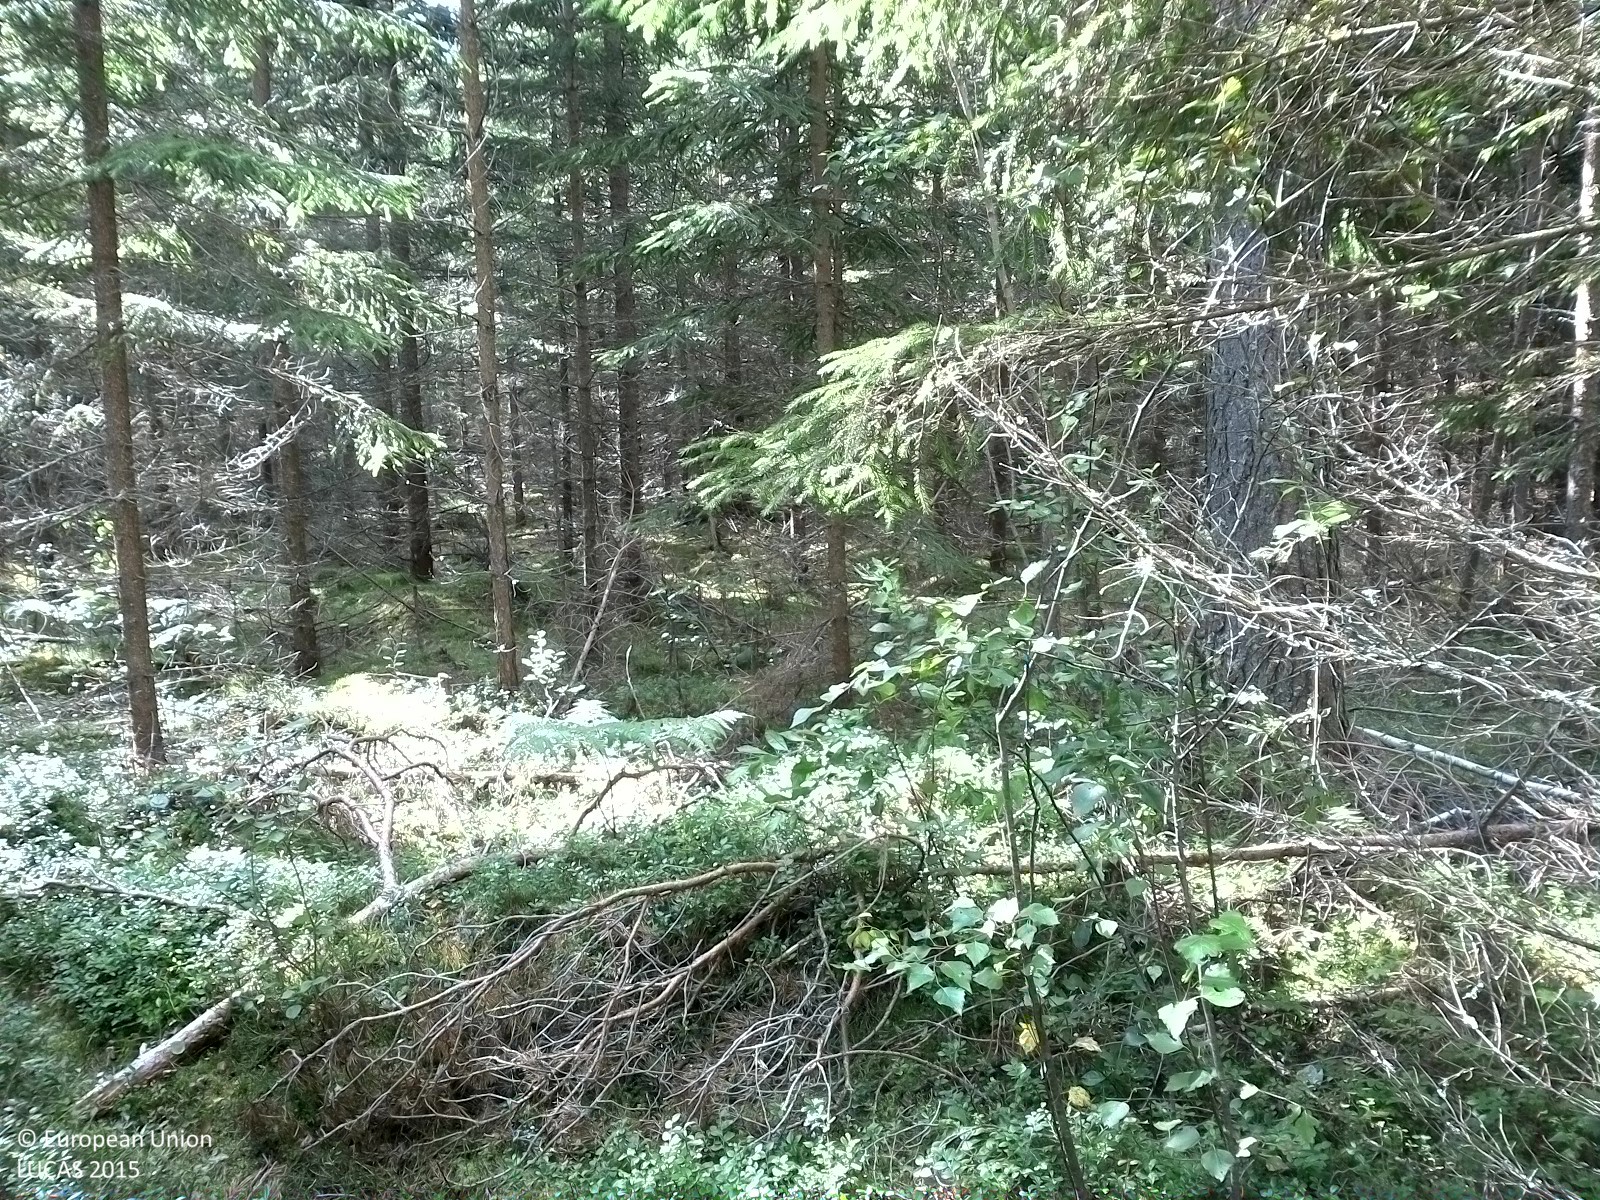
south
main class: Woodland
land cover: Other coniferous woodland
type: boreal forest
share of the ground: 50 - 75 %
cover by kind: coniferous forest trees 60 %, herbaceous plants 30 %, broadleaved forest trees 5 %, lichens and mosses 5 %
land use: Forestry
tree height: < 5 m
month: August
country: SE
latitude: 59.1474
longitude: 15.1842
